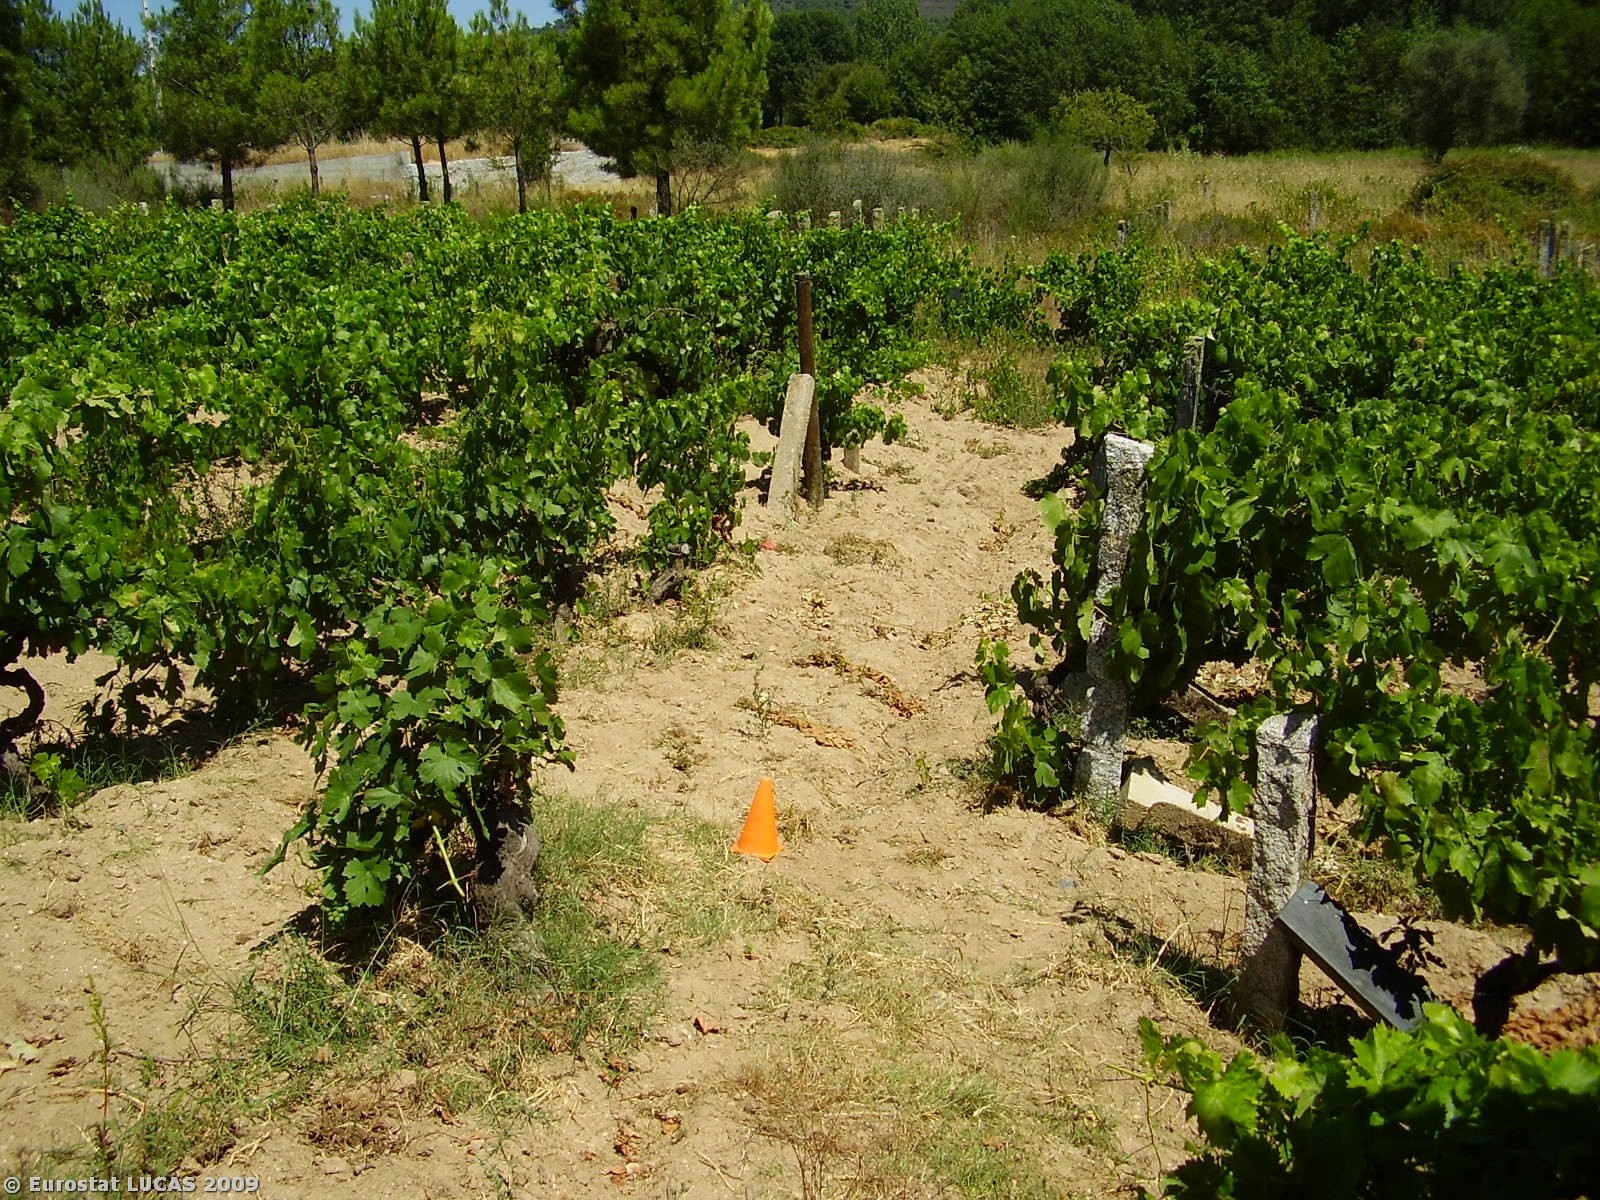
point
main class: Cropland
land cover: Vineyards
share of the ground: 50 - 75 %
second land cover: Bare land
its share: 10 - 25 %
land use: Agriculture (excluding fallow land and kitchen gardens)
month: July
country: PT
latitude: 41.7939
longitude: -7.4226
